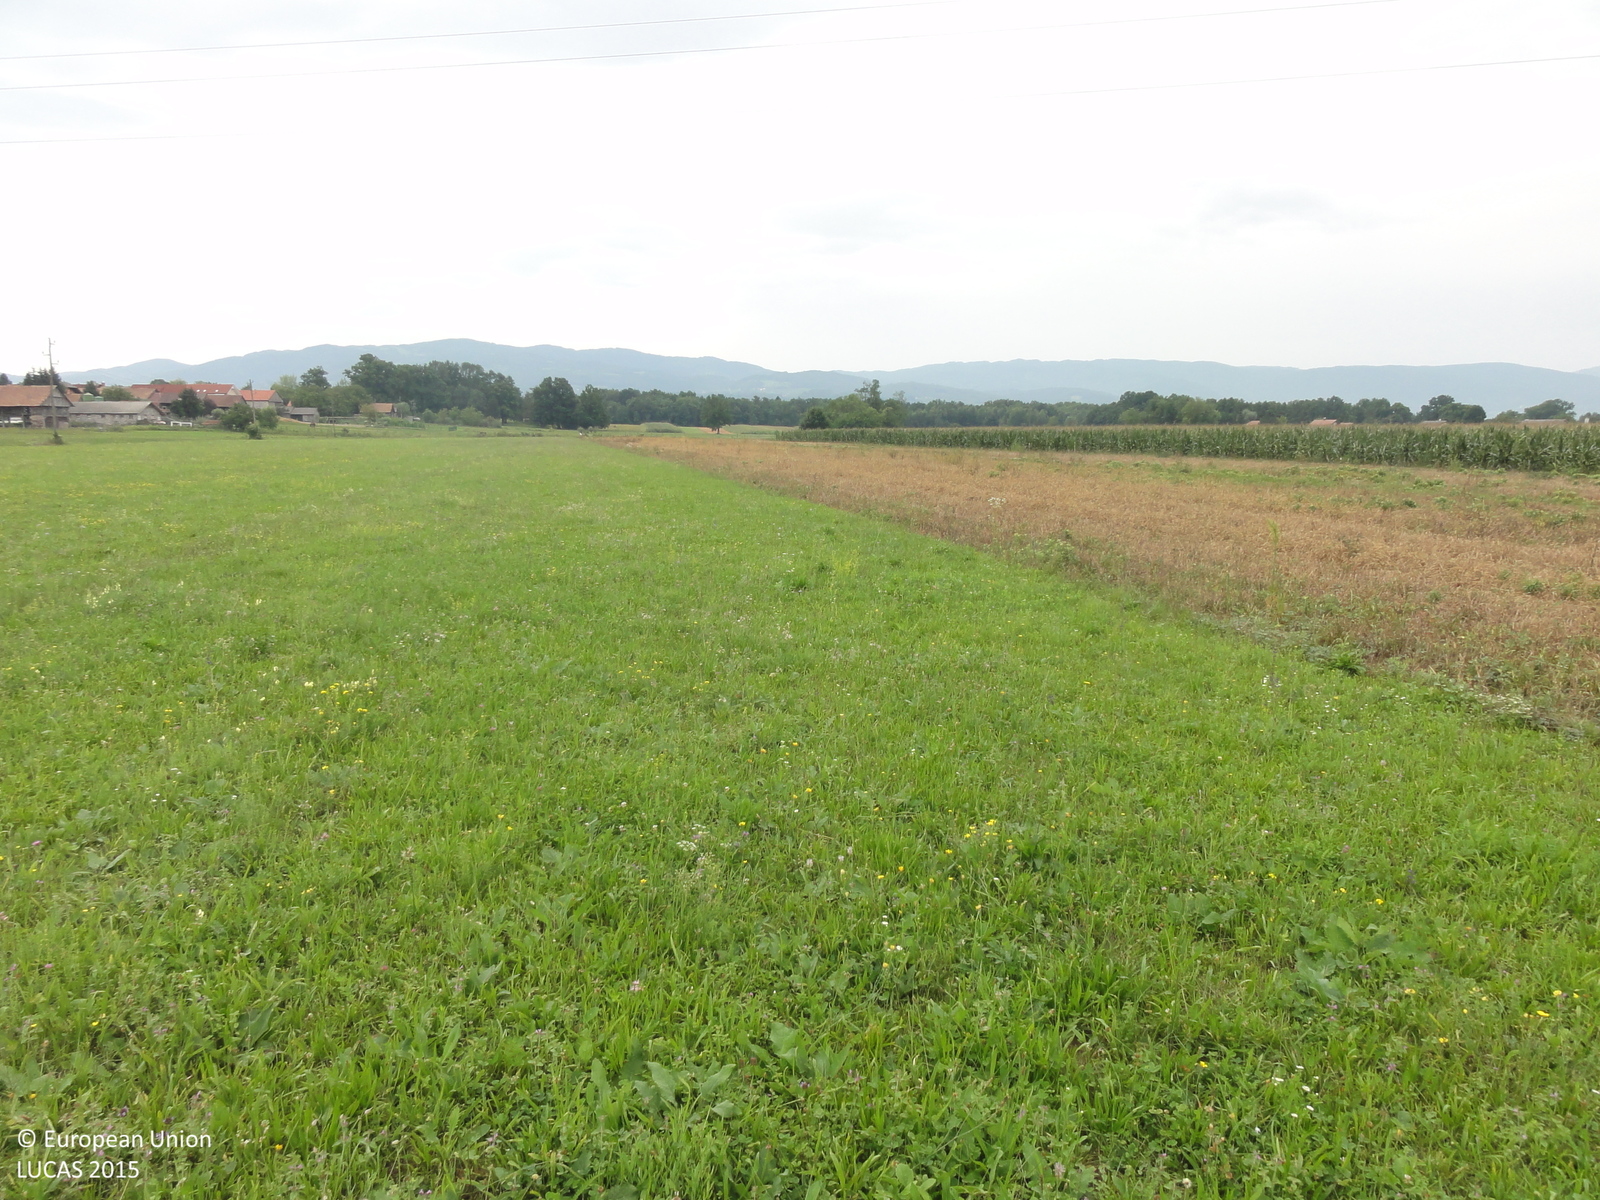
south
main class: Grassland
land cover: Grassland without tree/shrub cover
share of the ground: > 75 %
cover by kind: herbaceous plants 100 %
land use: Agriculture (excluding fallow land and kitchen gardens)
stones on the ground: < 10 %
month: August
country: SI
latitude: 45.9041
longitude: 15.4755
